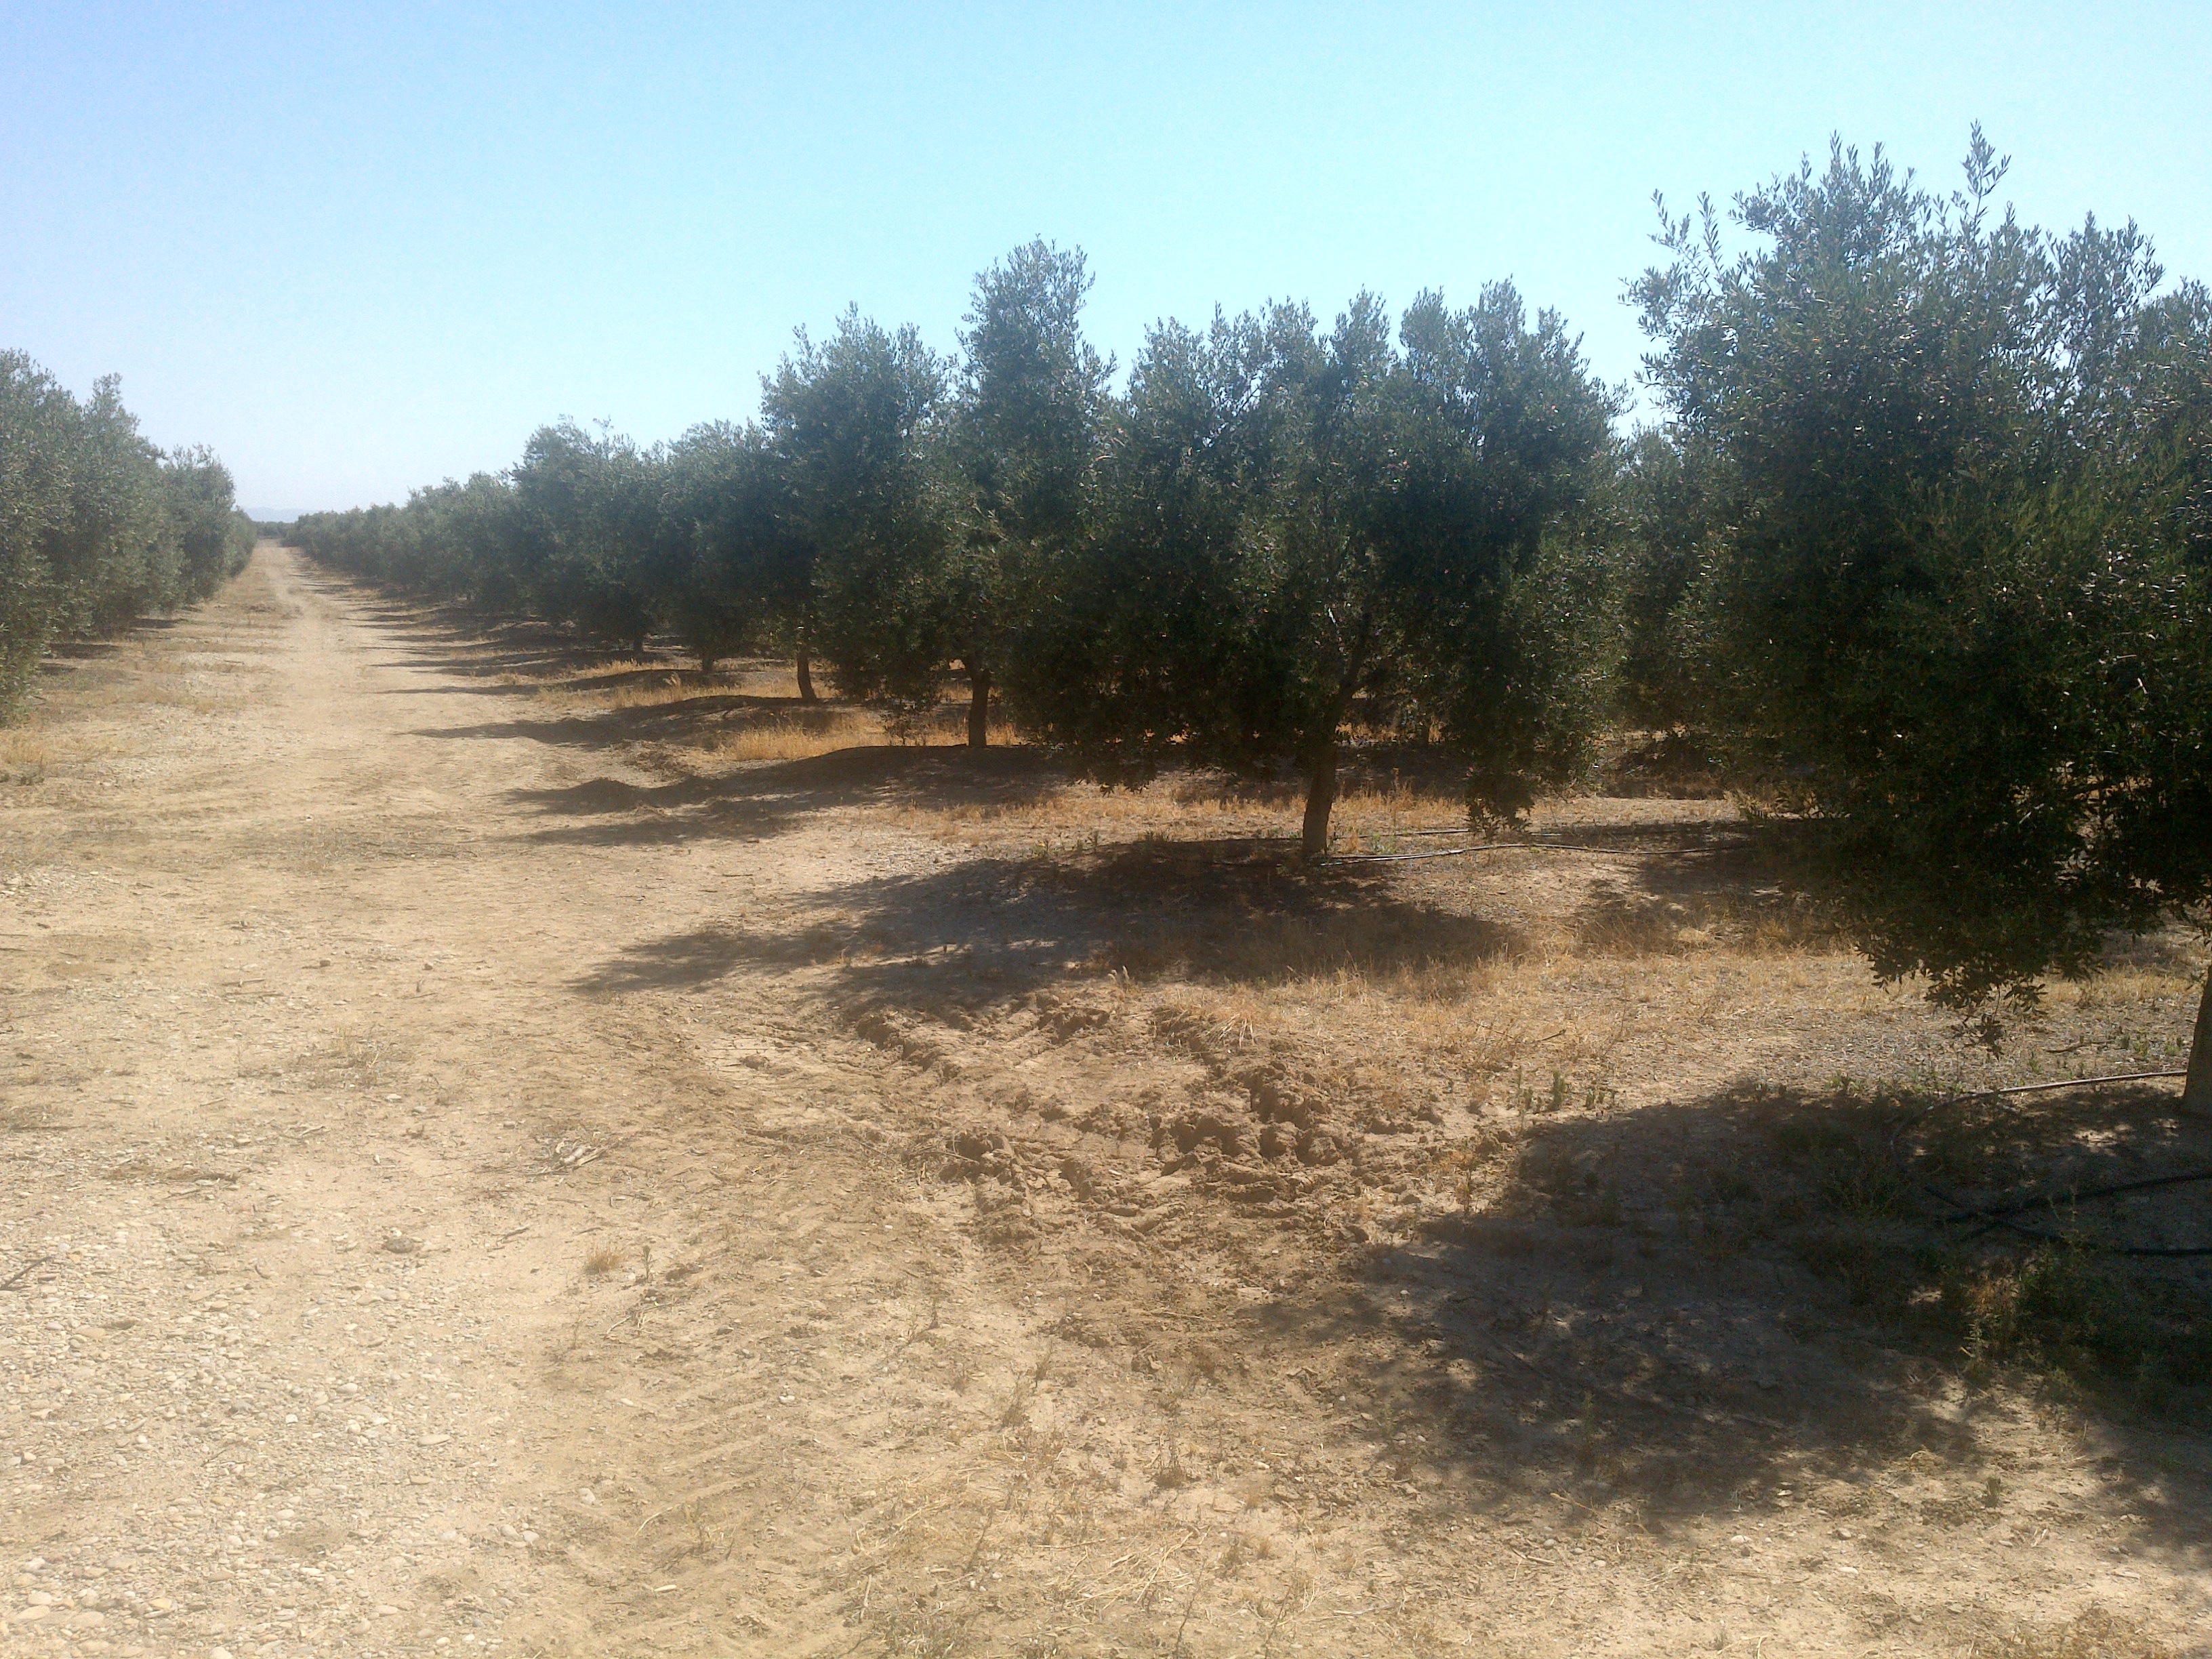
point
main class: Cropland
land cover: Olive groves
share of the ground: 50 - 75 %
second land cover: Spontaneously vegetated surfaces
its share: 10 - 25 %
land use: Agriculture (excluding fallow land and kitchen gardens)
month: June
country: ES
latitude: 37.7134
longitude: -5.2069
